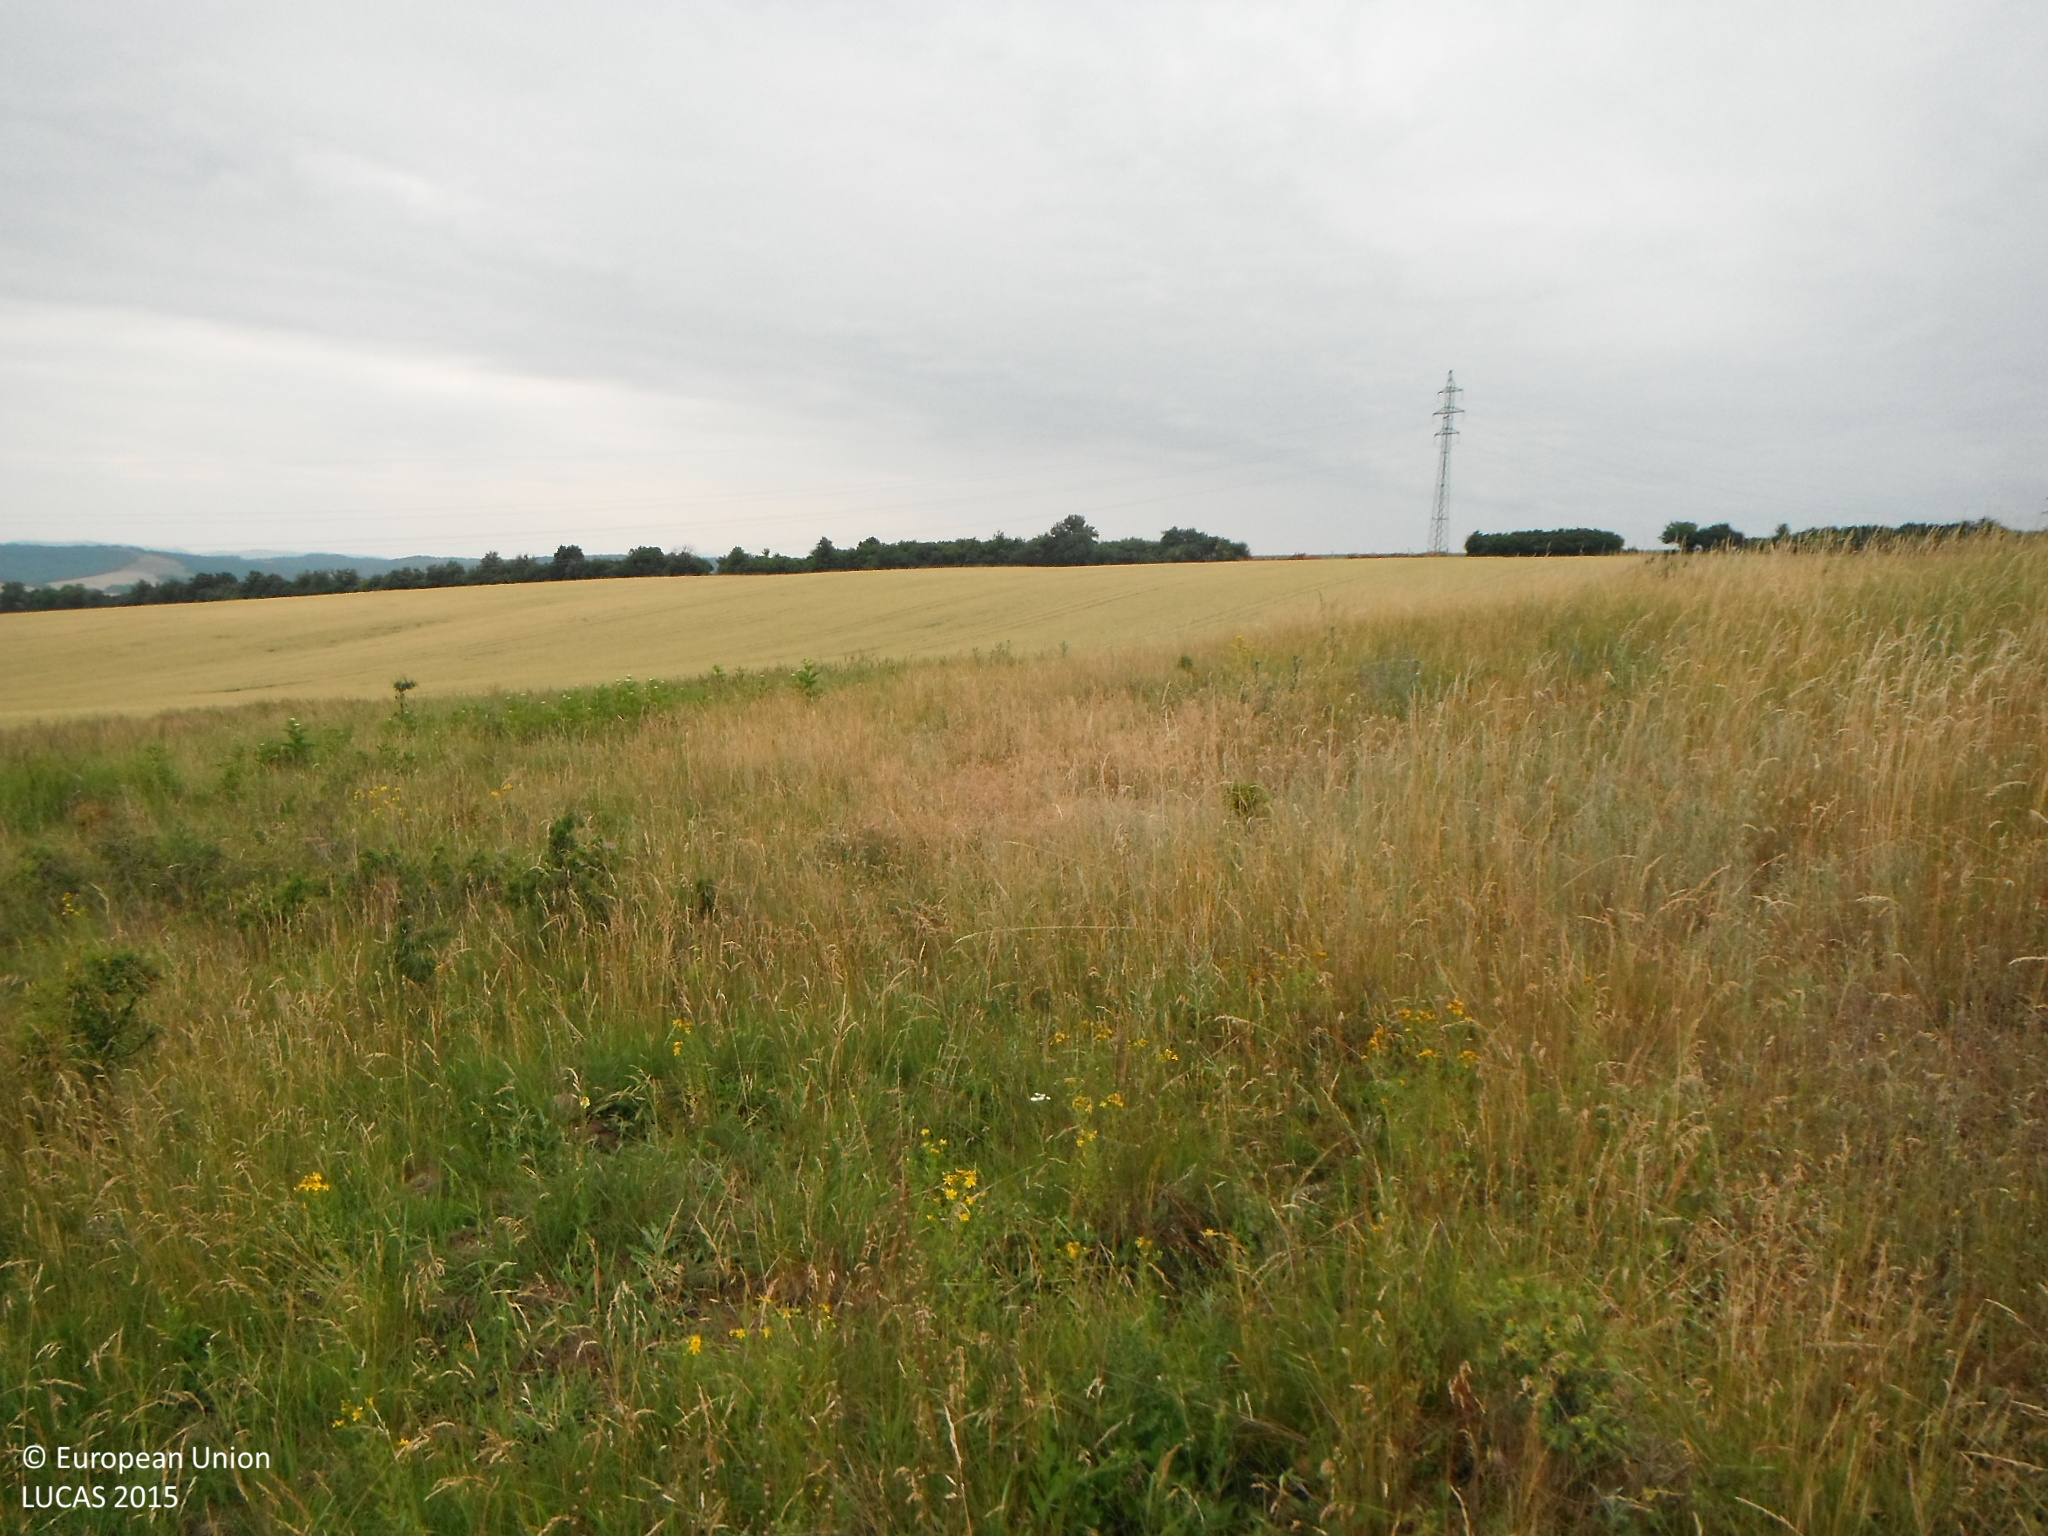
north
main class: Grassland
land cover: Grassland with sparse tree/shrub cover
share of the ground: > 75 %
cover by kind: herbaceous plants 85 %, shrubs 10 %, broadleaved forest trees 5 %
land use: Semi-natural and natural areas not in use
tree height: < 5 m
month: June
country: SK
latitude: 48.1279
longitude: 18.9811
